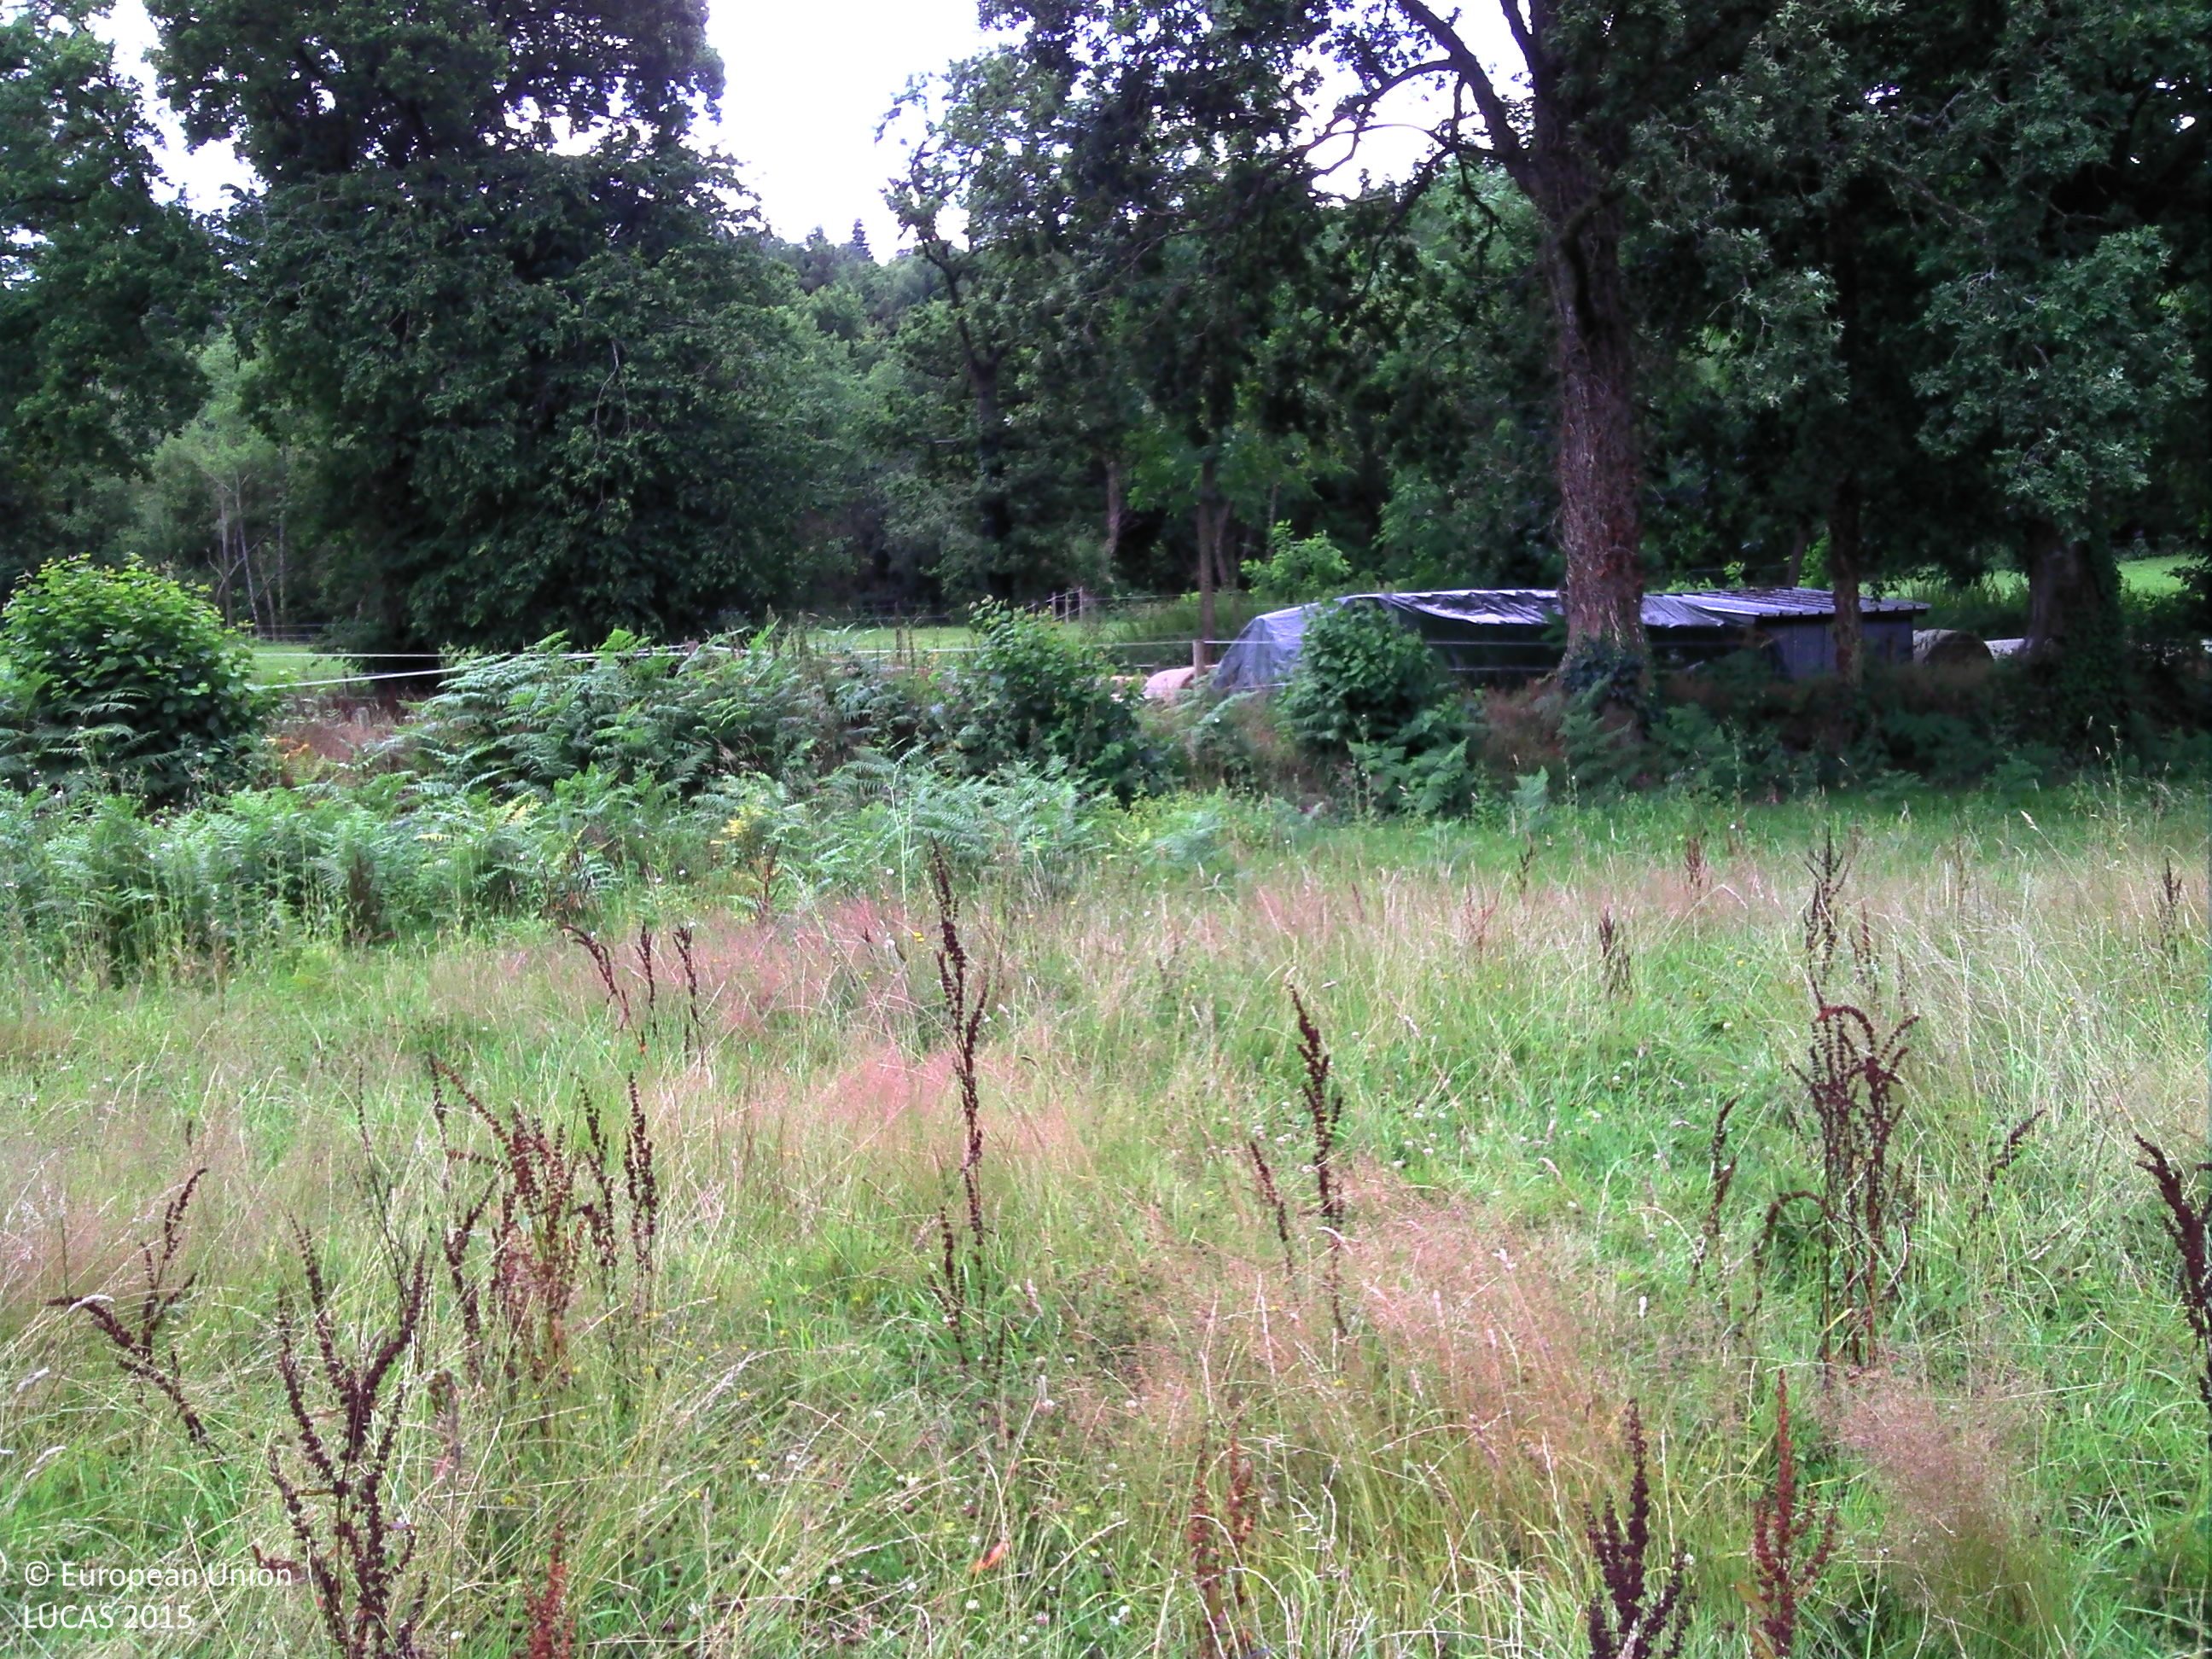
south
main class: Grassland
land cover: Grassland without tree/shrub cover
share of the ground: > 75 %
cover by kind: herbaceous plants 75 %, consolidated bare surface 20 %, shrubs 5 %
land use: Agriculture (excluding fallow land and kitchen gardens)
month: July
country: FR
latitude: 47.8664
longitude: -3.0212
